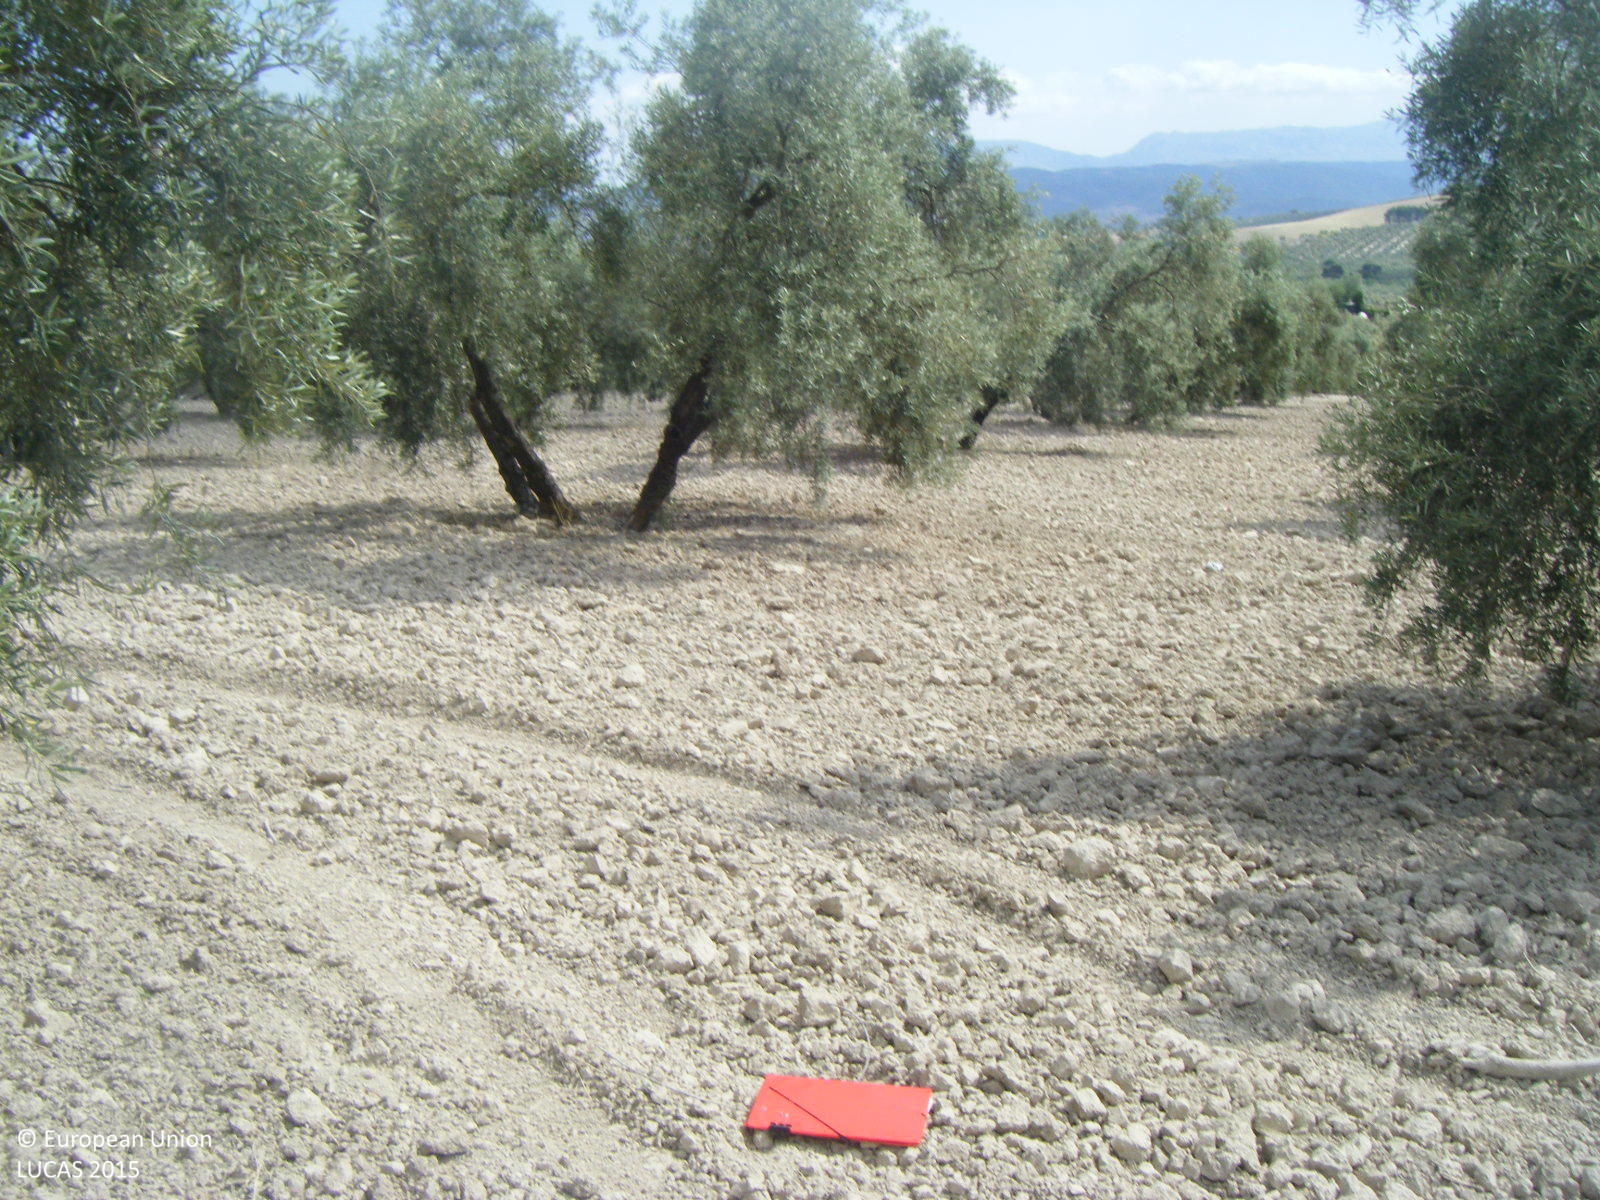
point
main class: Cropland
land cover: Olive groves
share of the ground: 10 - 25 %
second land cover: Other bare soil
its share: > 75 %
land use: Agriculture (excluding fallow land and kitchen gardens)
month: May
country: ES
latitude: 37.1356
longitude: -4.4401
